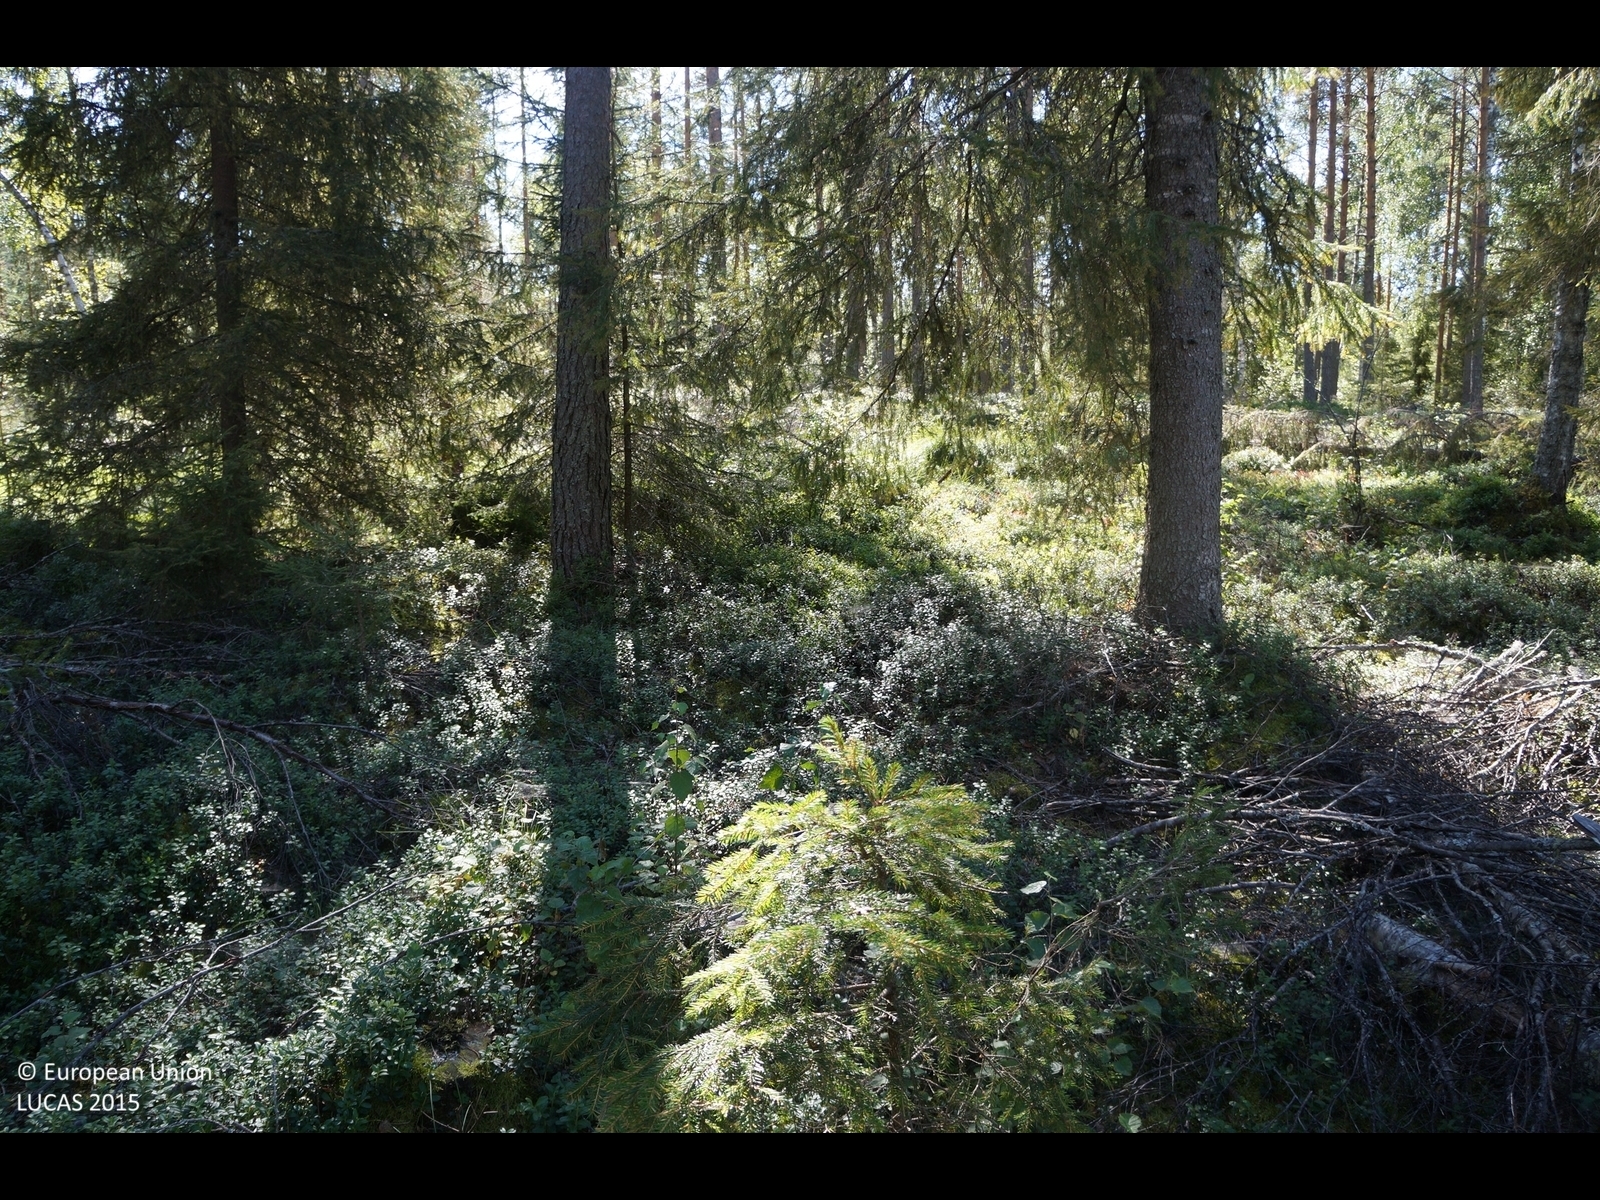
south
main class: Woodland
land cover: Other mixed woodland
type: boreal forest
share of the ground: 50 - 75 %
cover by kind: coniferous forest trees 35 %, shrubs 30 %, broadleaved forest trees 20 %, lichens and mosses 10 %, herbaceous plants 5 %
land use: Forestry
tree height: > 5 m
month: August
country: FI
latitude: 63.9393
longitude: 23.7928
